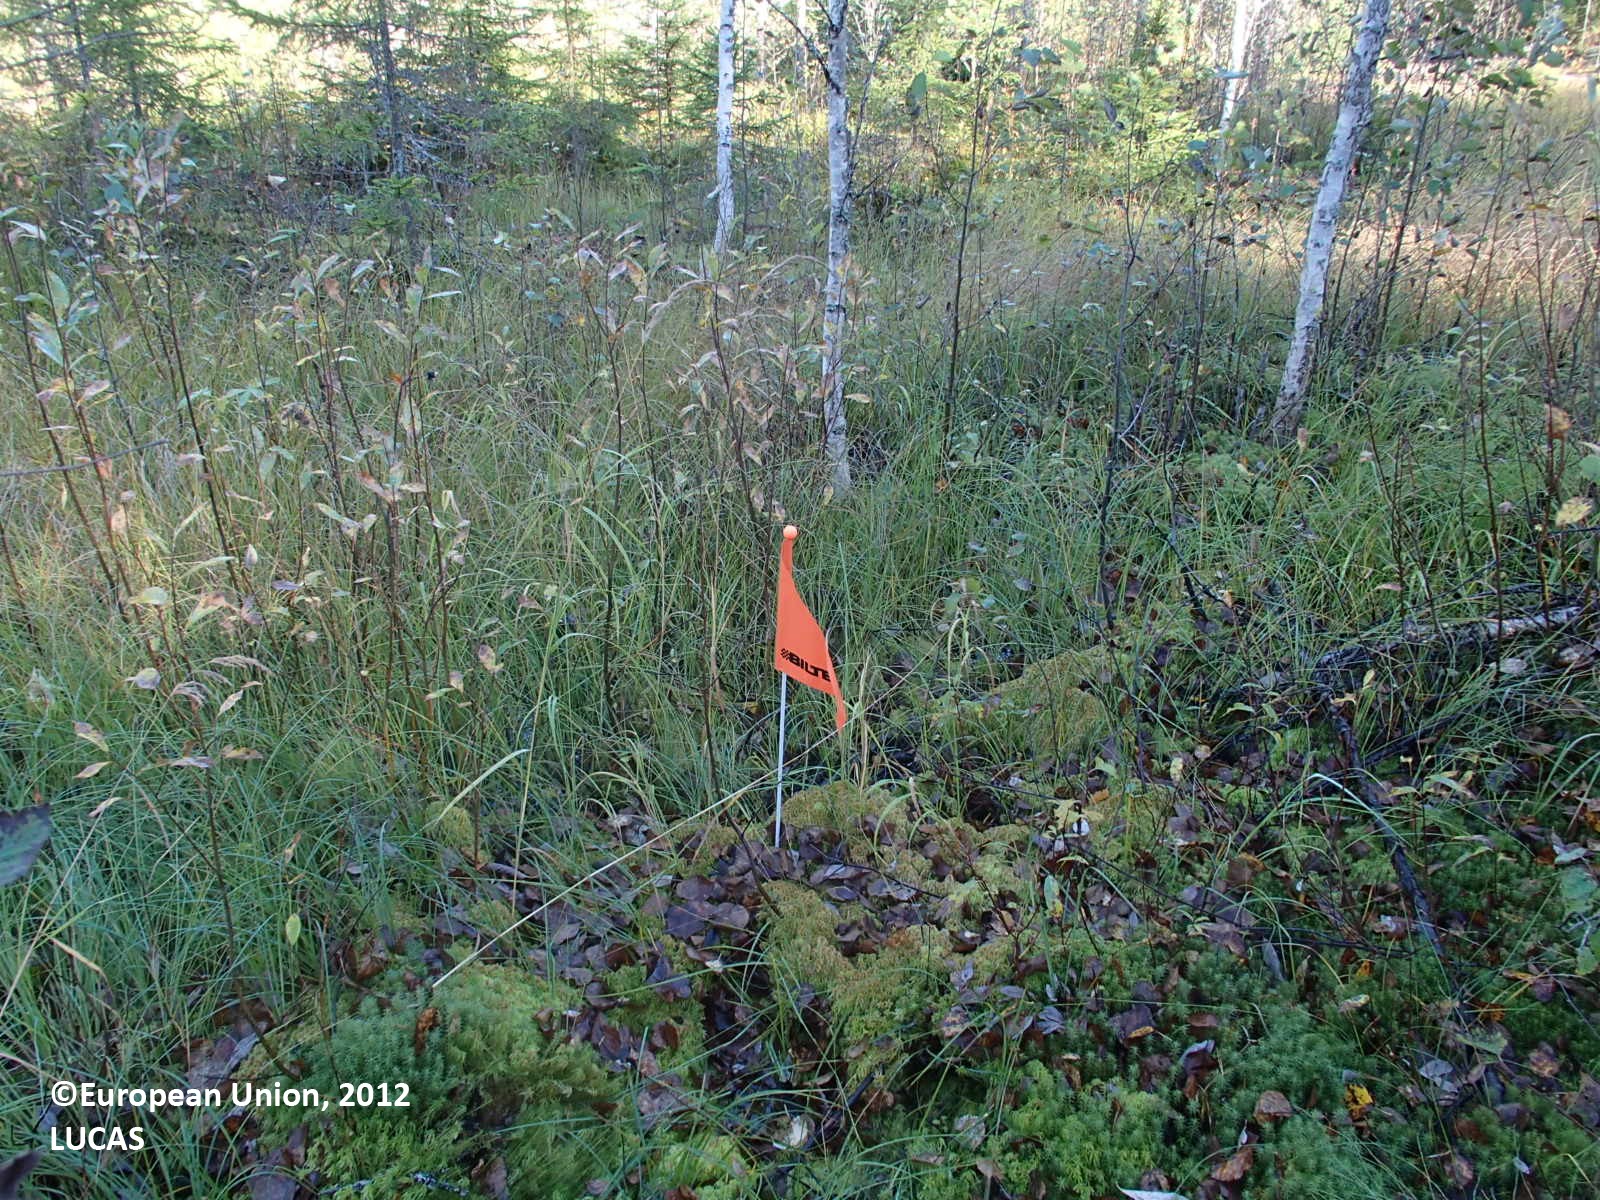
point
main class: Woodland
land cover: Pine dominated mixed woodland
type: boreal forest
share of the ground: 25 - 50 %
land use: Forestry
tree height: > 5 m
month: September
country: FI
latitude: 63.4246
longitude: 26.9083
